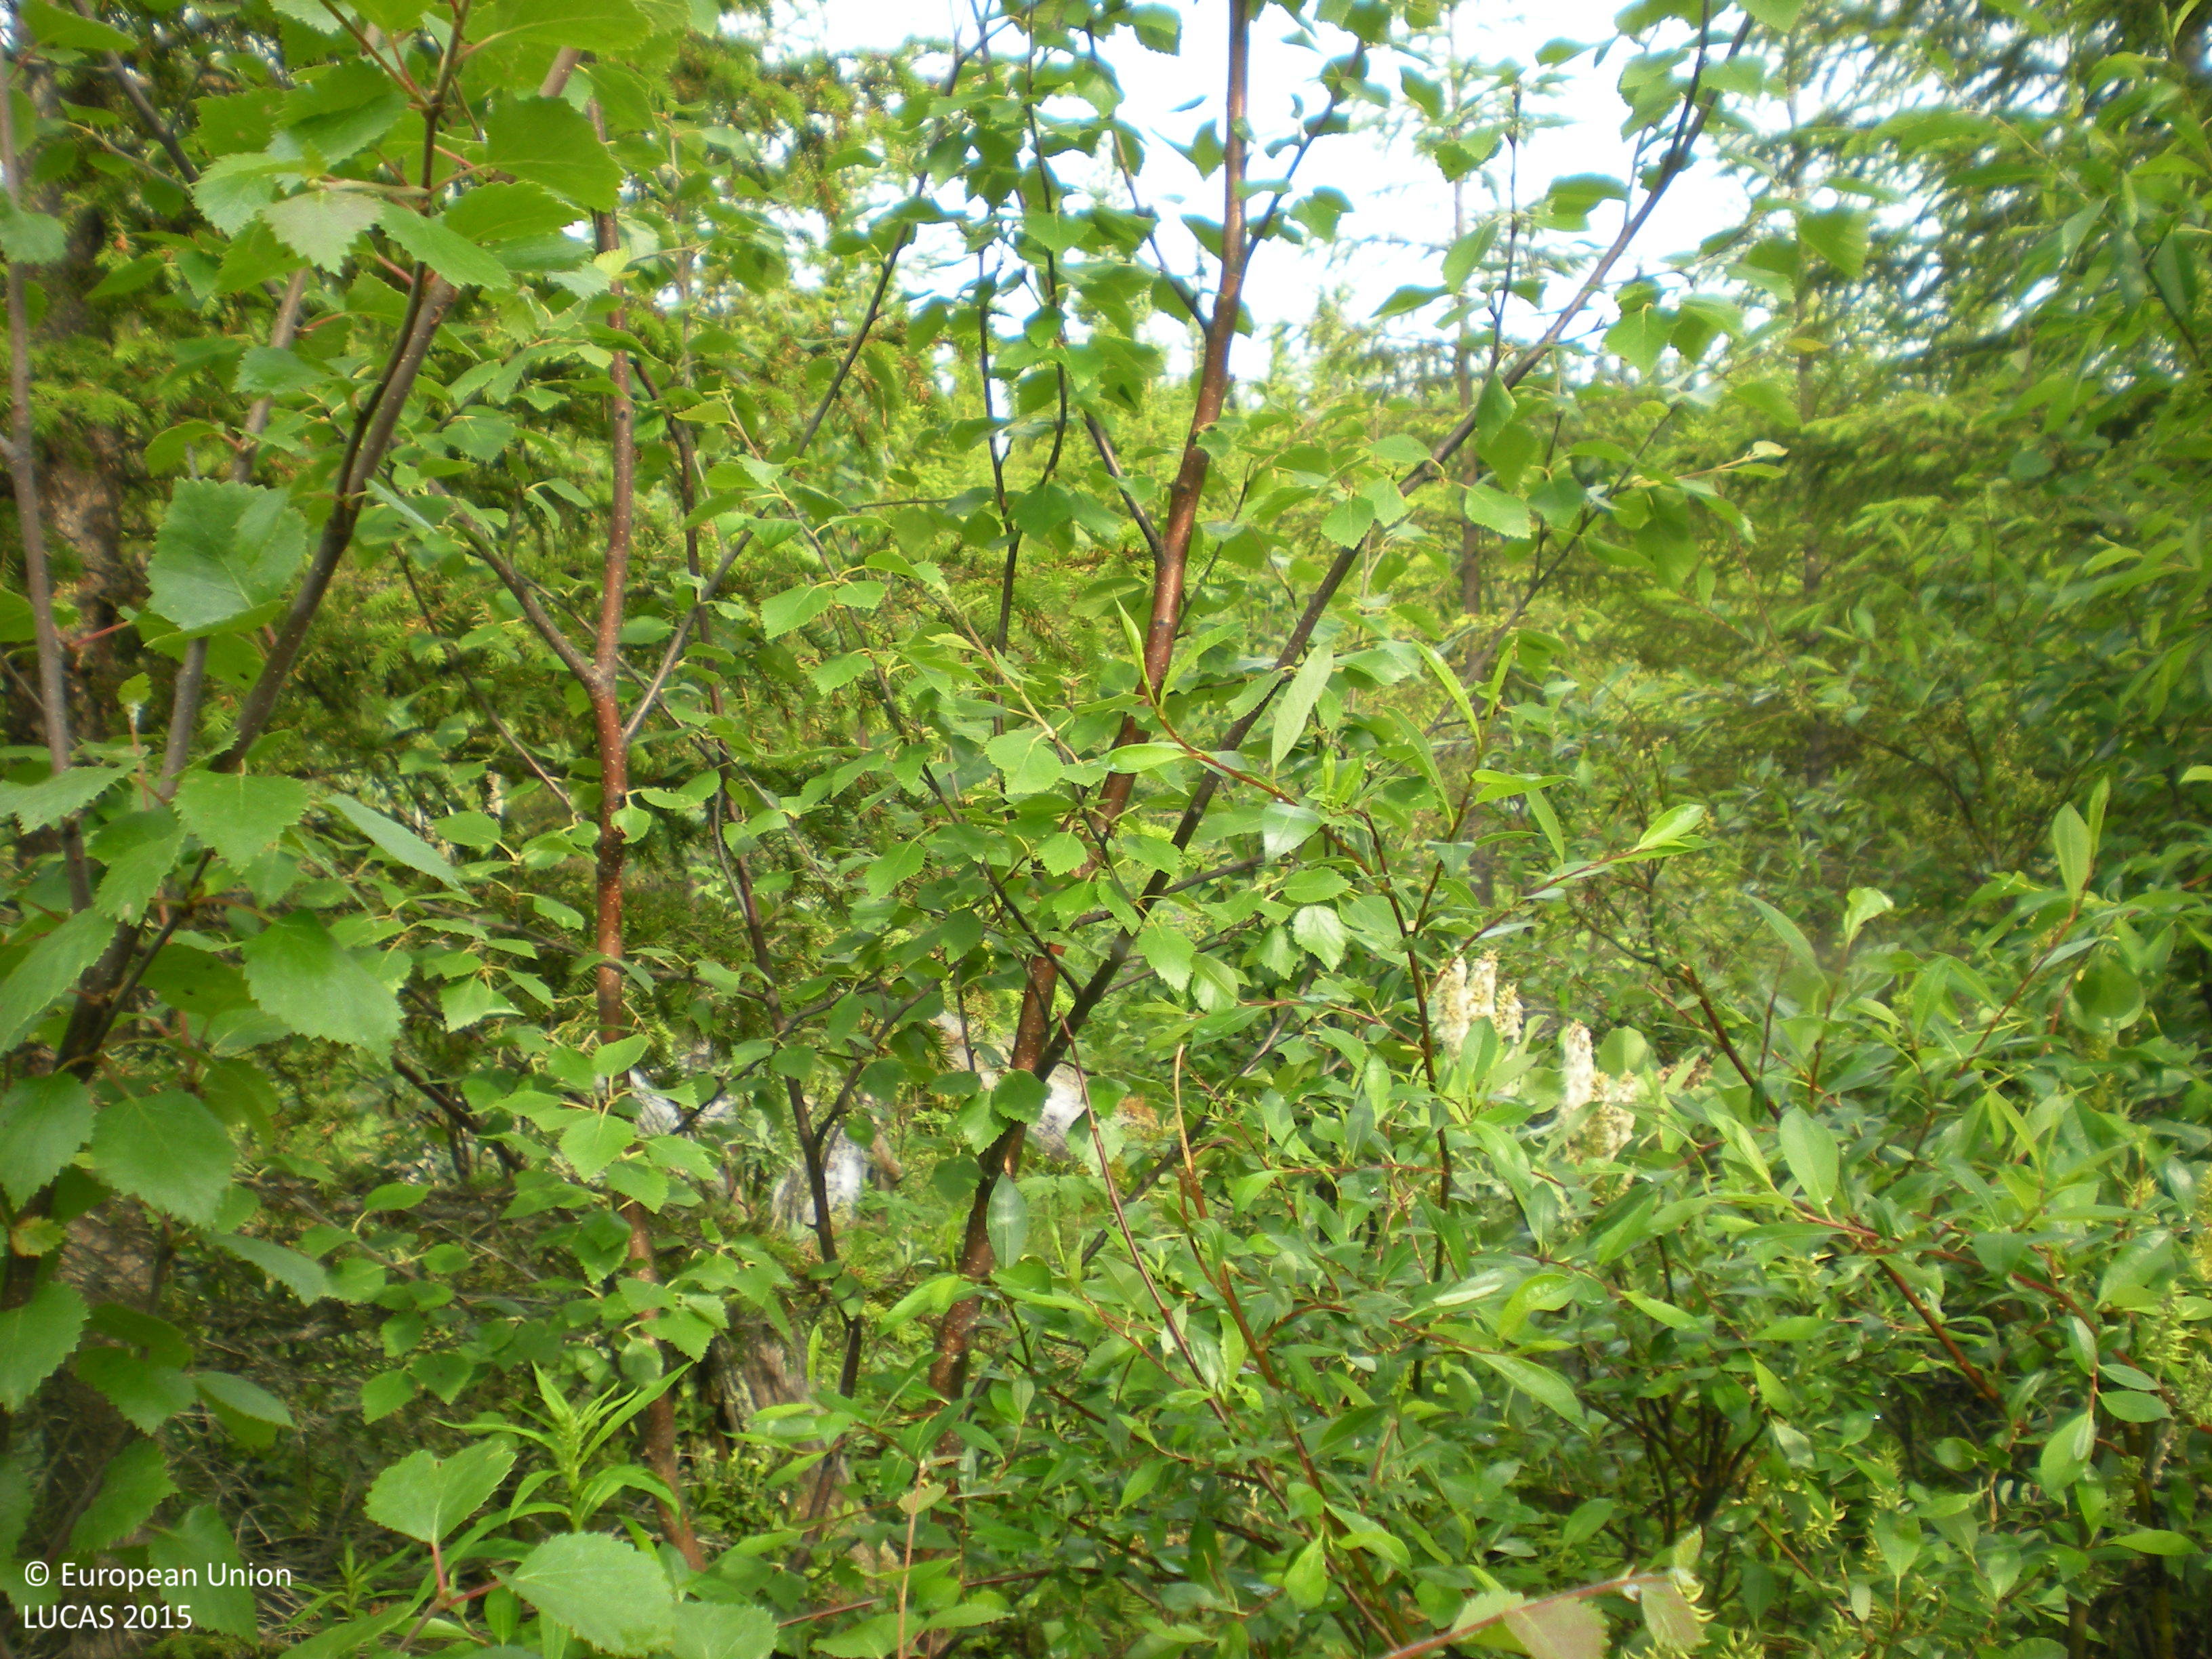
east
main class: Woodland
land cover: Spruce dominated mixed woodland
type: boreal forest
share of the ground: > 75 %
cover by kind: coniferous forest trees 45 %, broadleaved forest trees 40 %, herbaceous plants 10 %, shrubs 5 %
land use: Forestry
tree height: < 5 m
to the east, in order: Spruce dominated mixed woodland; Spruce dominated coniferous woodland
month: July
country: SE
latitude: 65.9598
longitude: 17.1943
